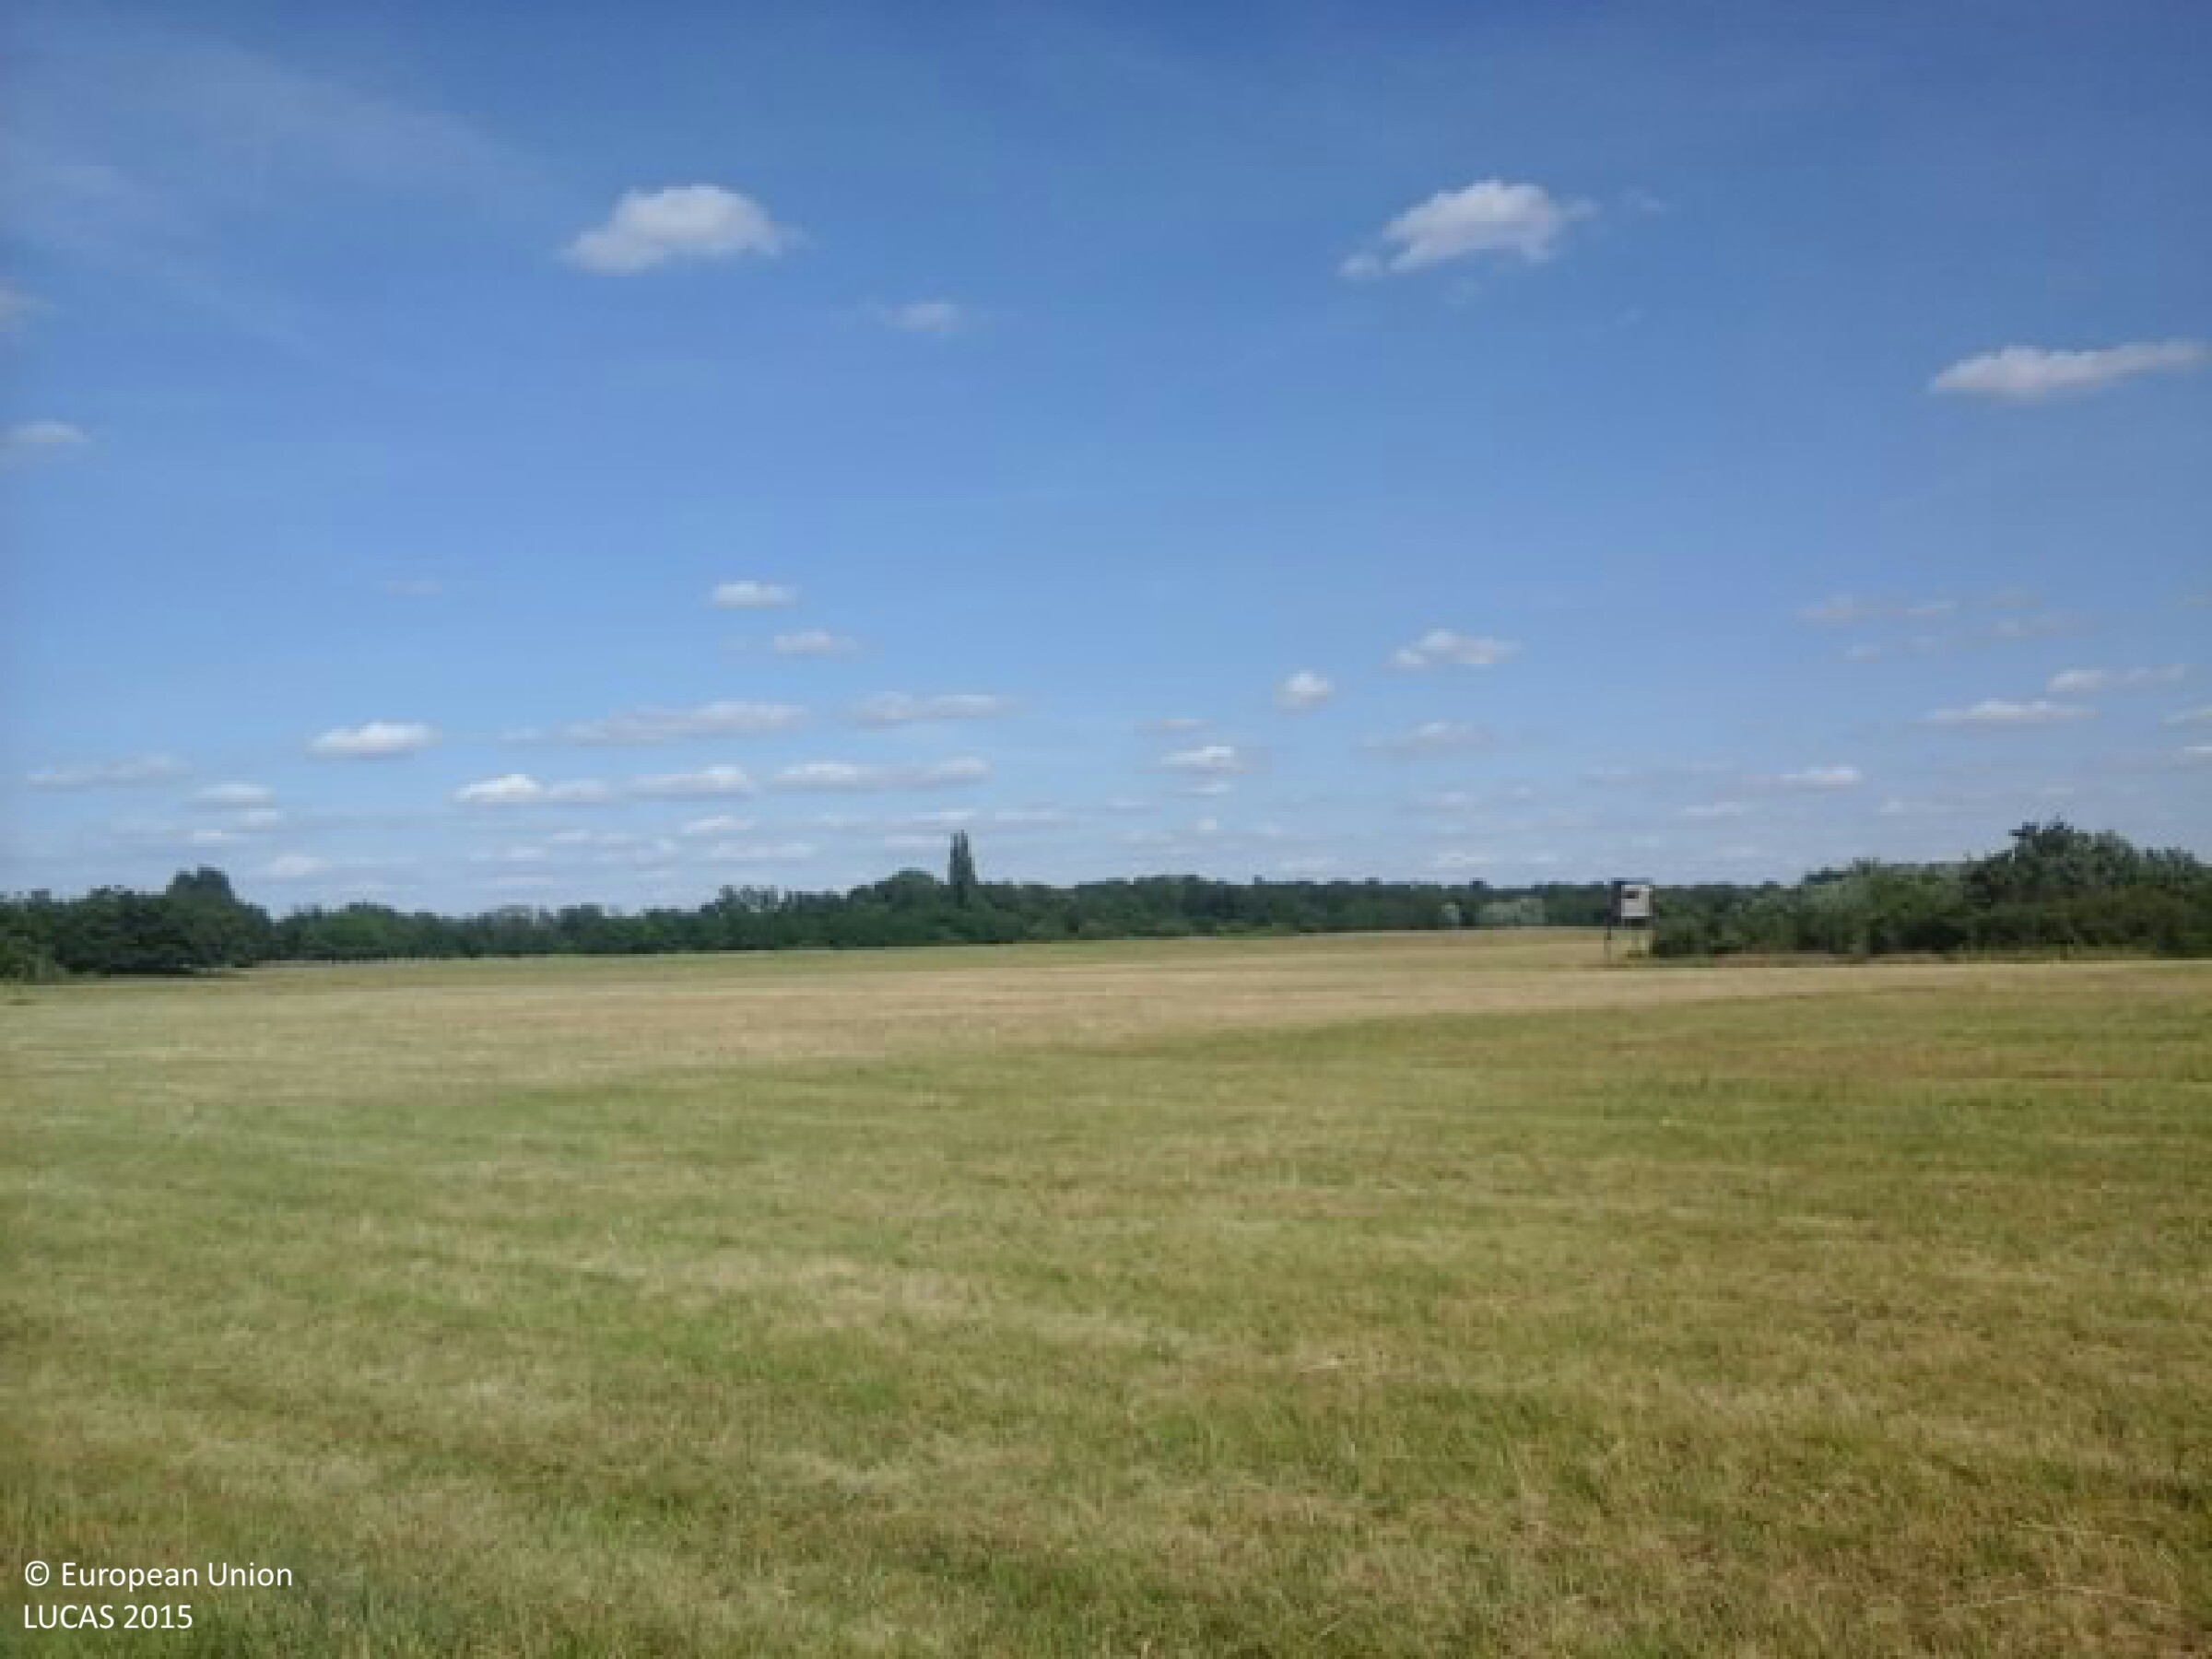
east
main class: Grassland
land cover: Grassland without tree/shrub cover
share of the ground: > 75 %
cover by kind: herbaceous plants 100 %
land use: Agriculture (excluding fallow land and kitchen gardens)
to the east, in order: Grassland without tree/shrub cover; Lucerne
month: June
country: HU
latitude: 46.2811
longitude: 19.1898
